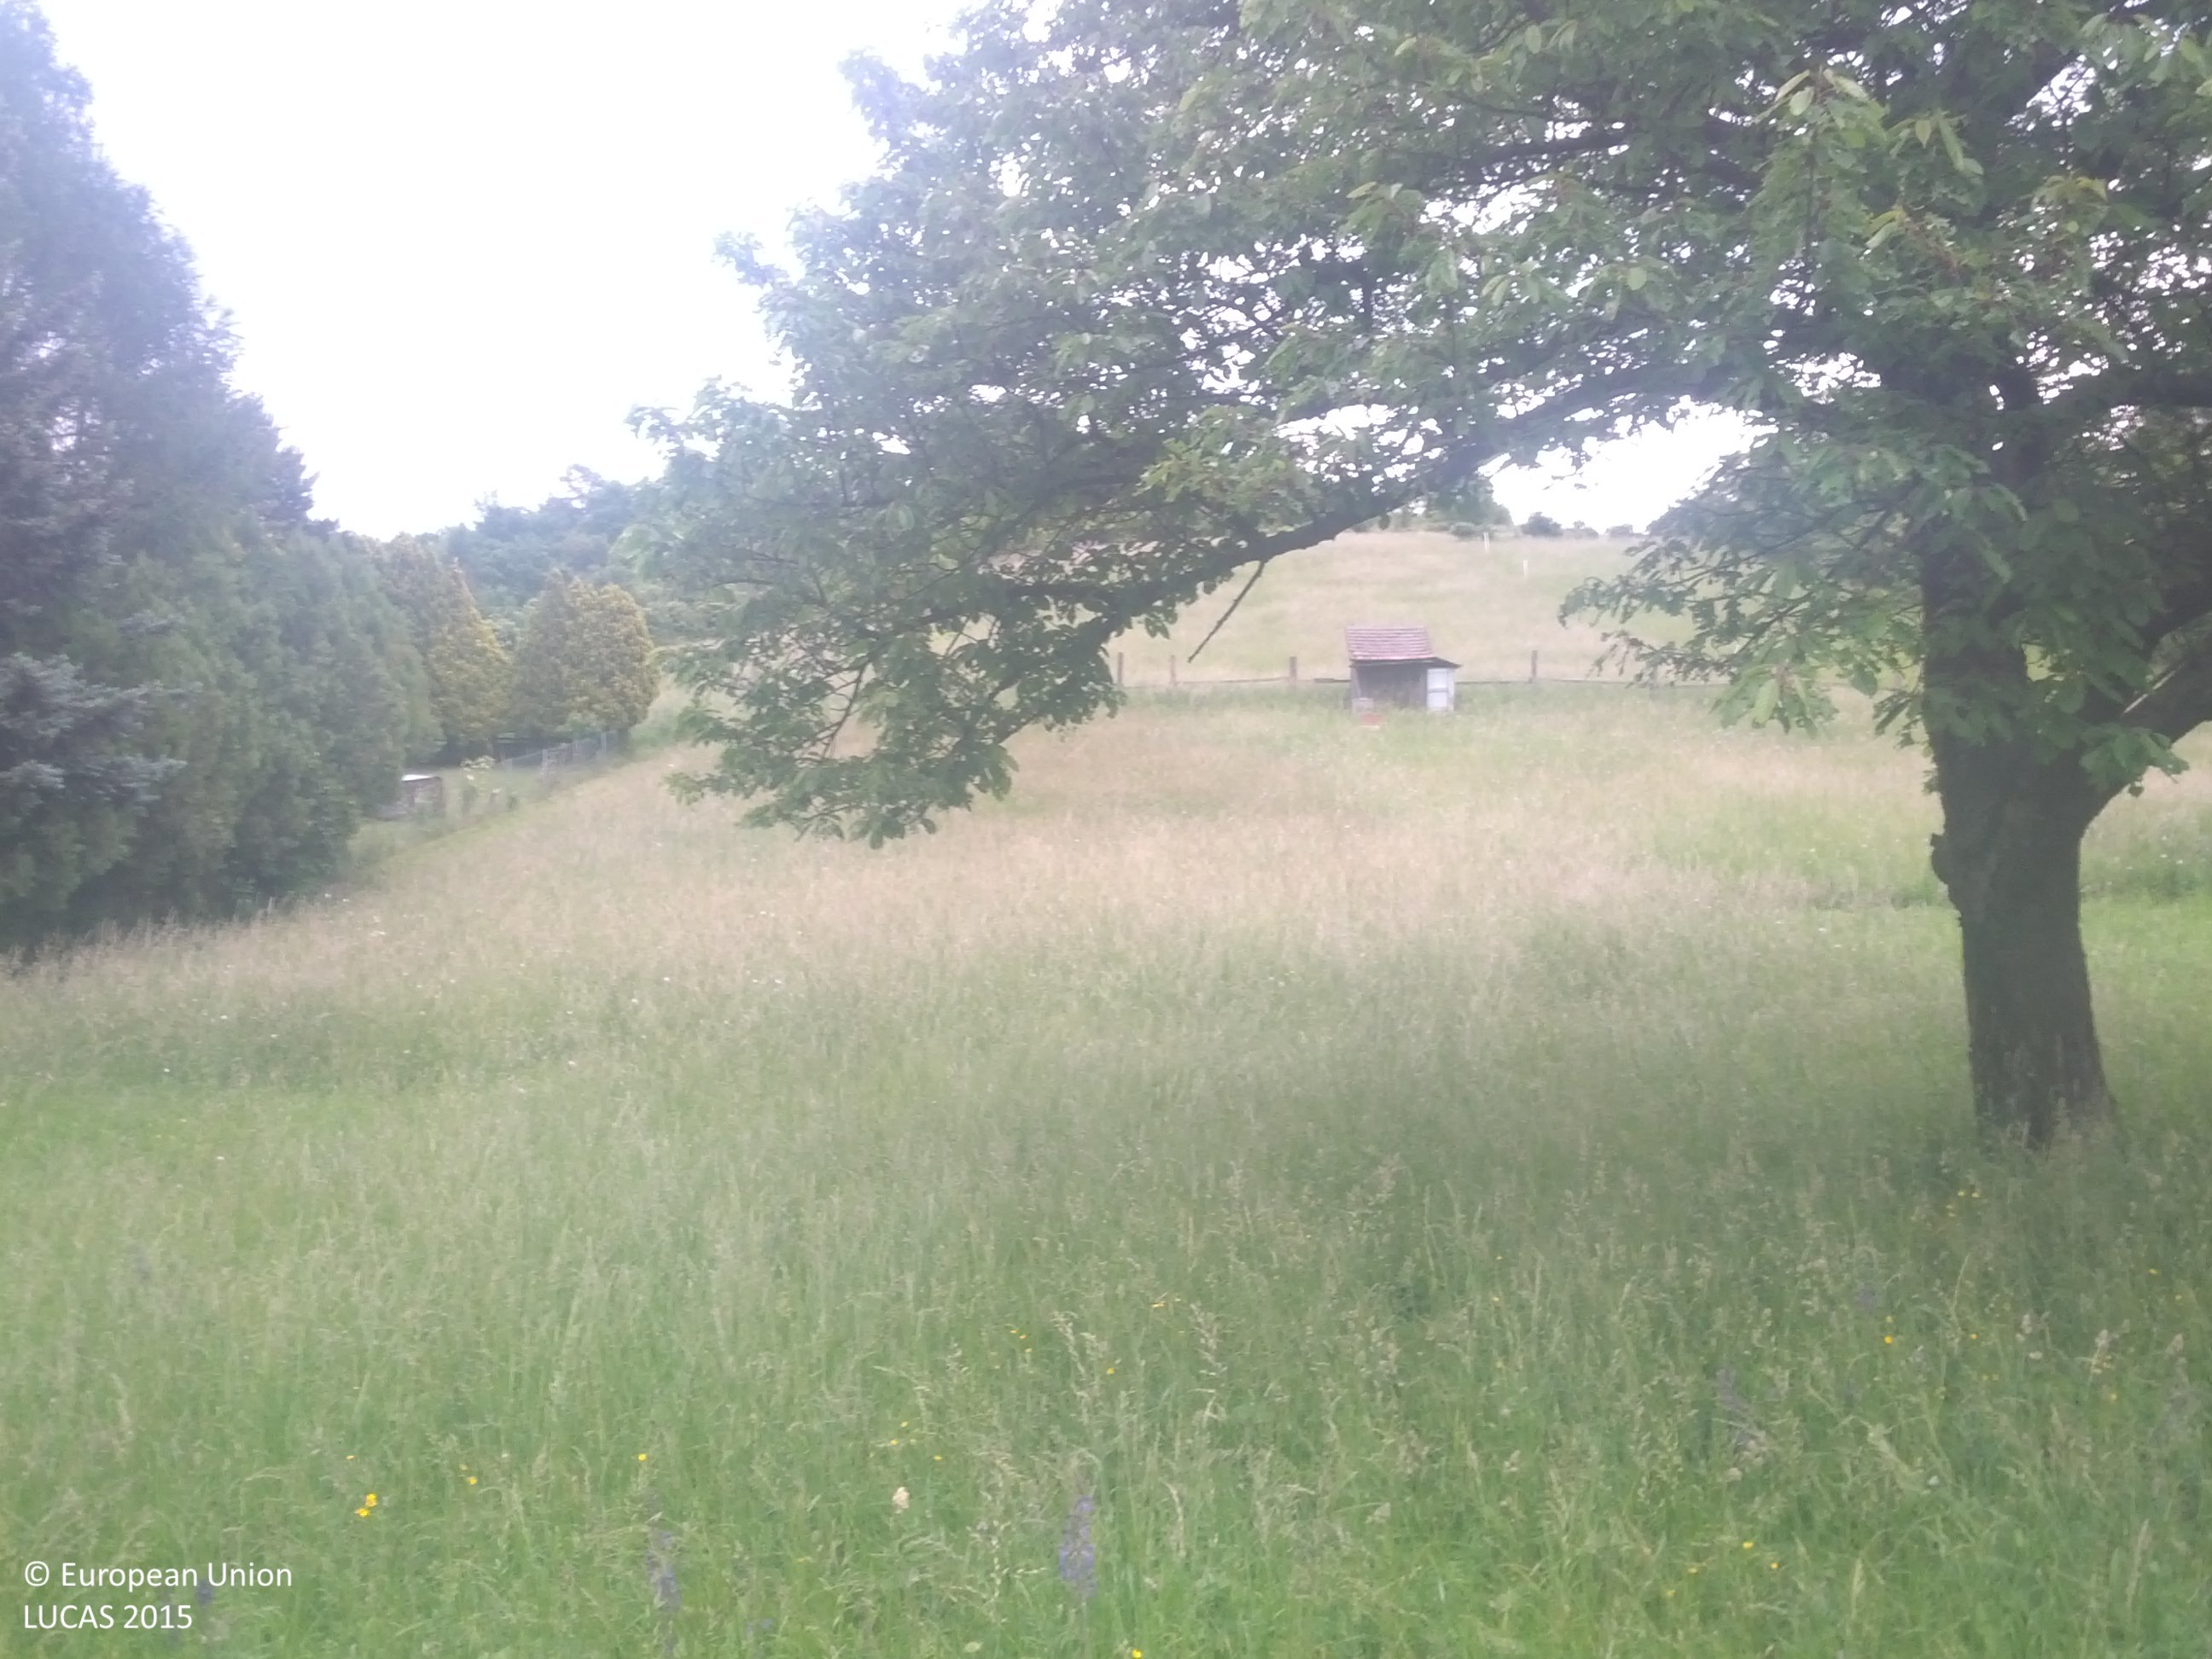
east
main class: Cropland
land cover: Cherry fruit
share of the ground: < 10 %
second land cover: Grassland without tree/shrub cover
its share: > 75 %
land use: Agriculture (excluding fallow land and kitchen gardens)
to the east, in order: Cherry fruit; Grassland without tree/shrub cover; Fences; Grassland without tree/shrub cover; Broadleaved woodland; Grassland without tree/shrub cover; Broadleaved woodland; Fences; Broadleaved woodland; Grassland without tree/shrub cover
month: May
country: AT
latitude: 48.3036
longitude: 16.1656
